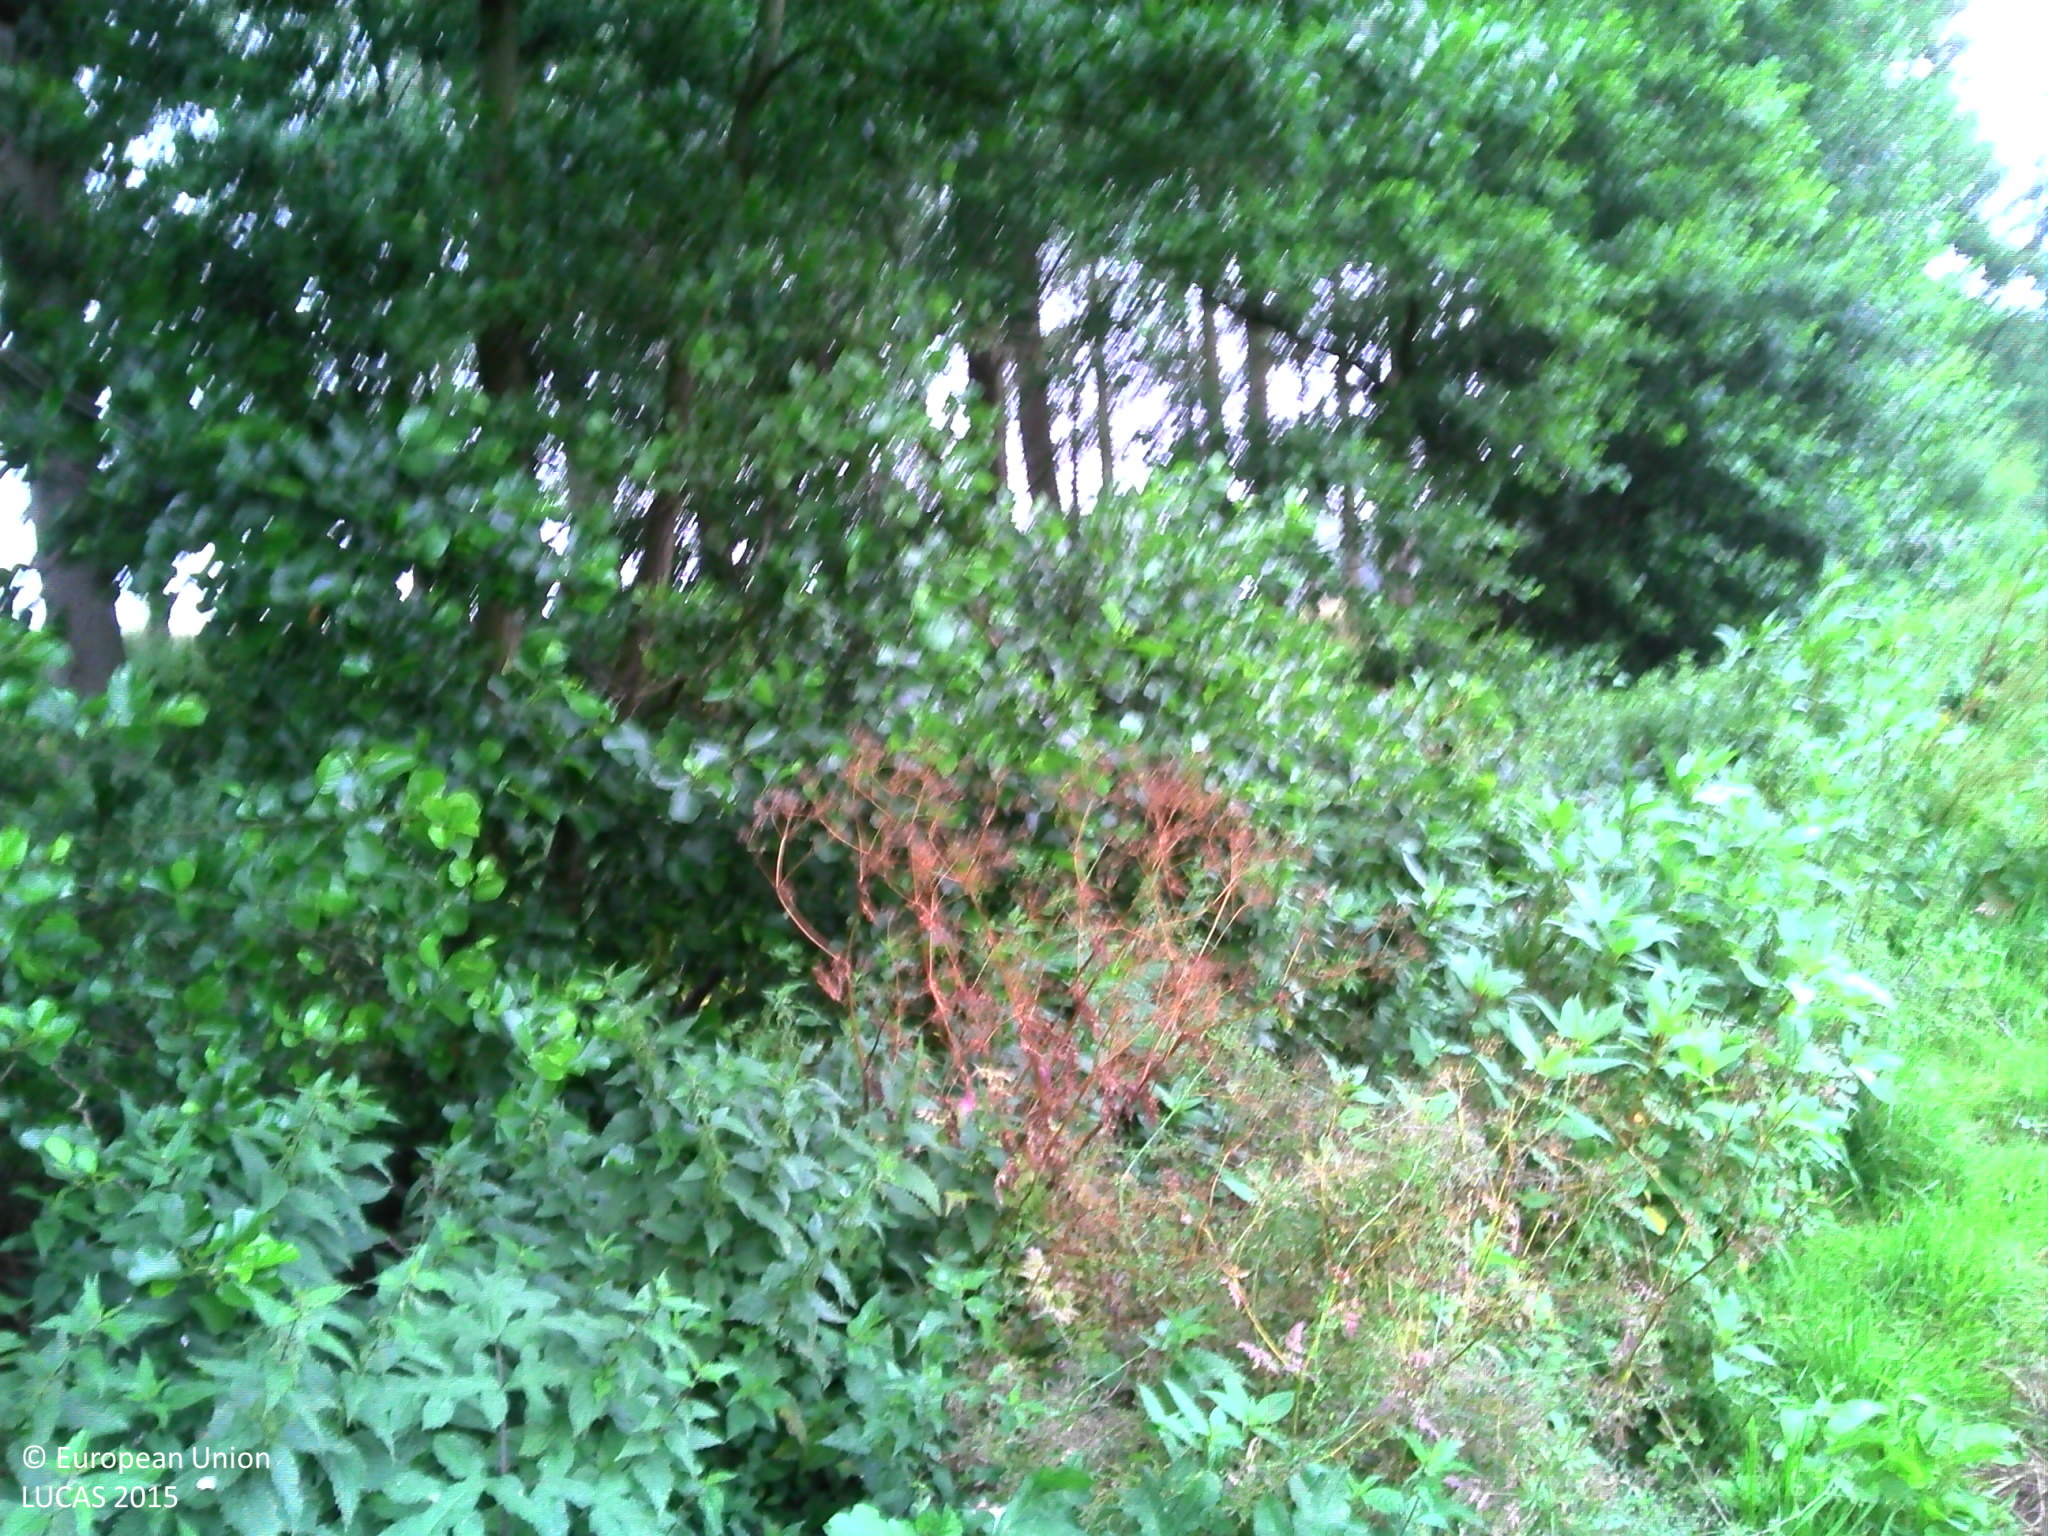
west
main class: Grassland
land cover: Grassland without tree/shrub cover
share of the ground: > 75 %
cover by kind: herbaceous plants 95 %, shrubs 5 %
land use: Agriculture (excluding fallow land and kitchen gardens)
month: July
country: BE
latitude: 50.6221
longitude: 4.0152
